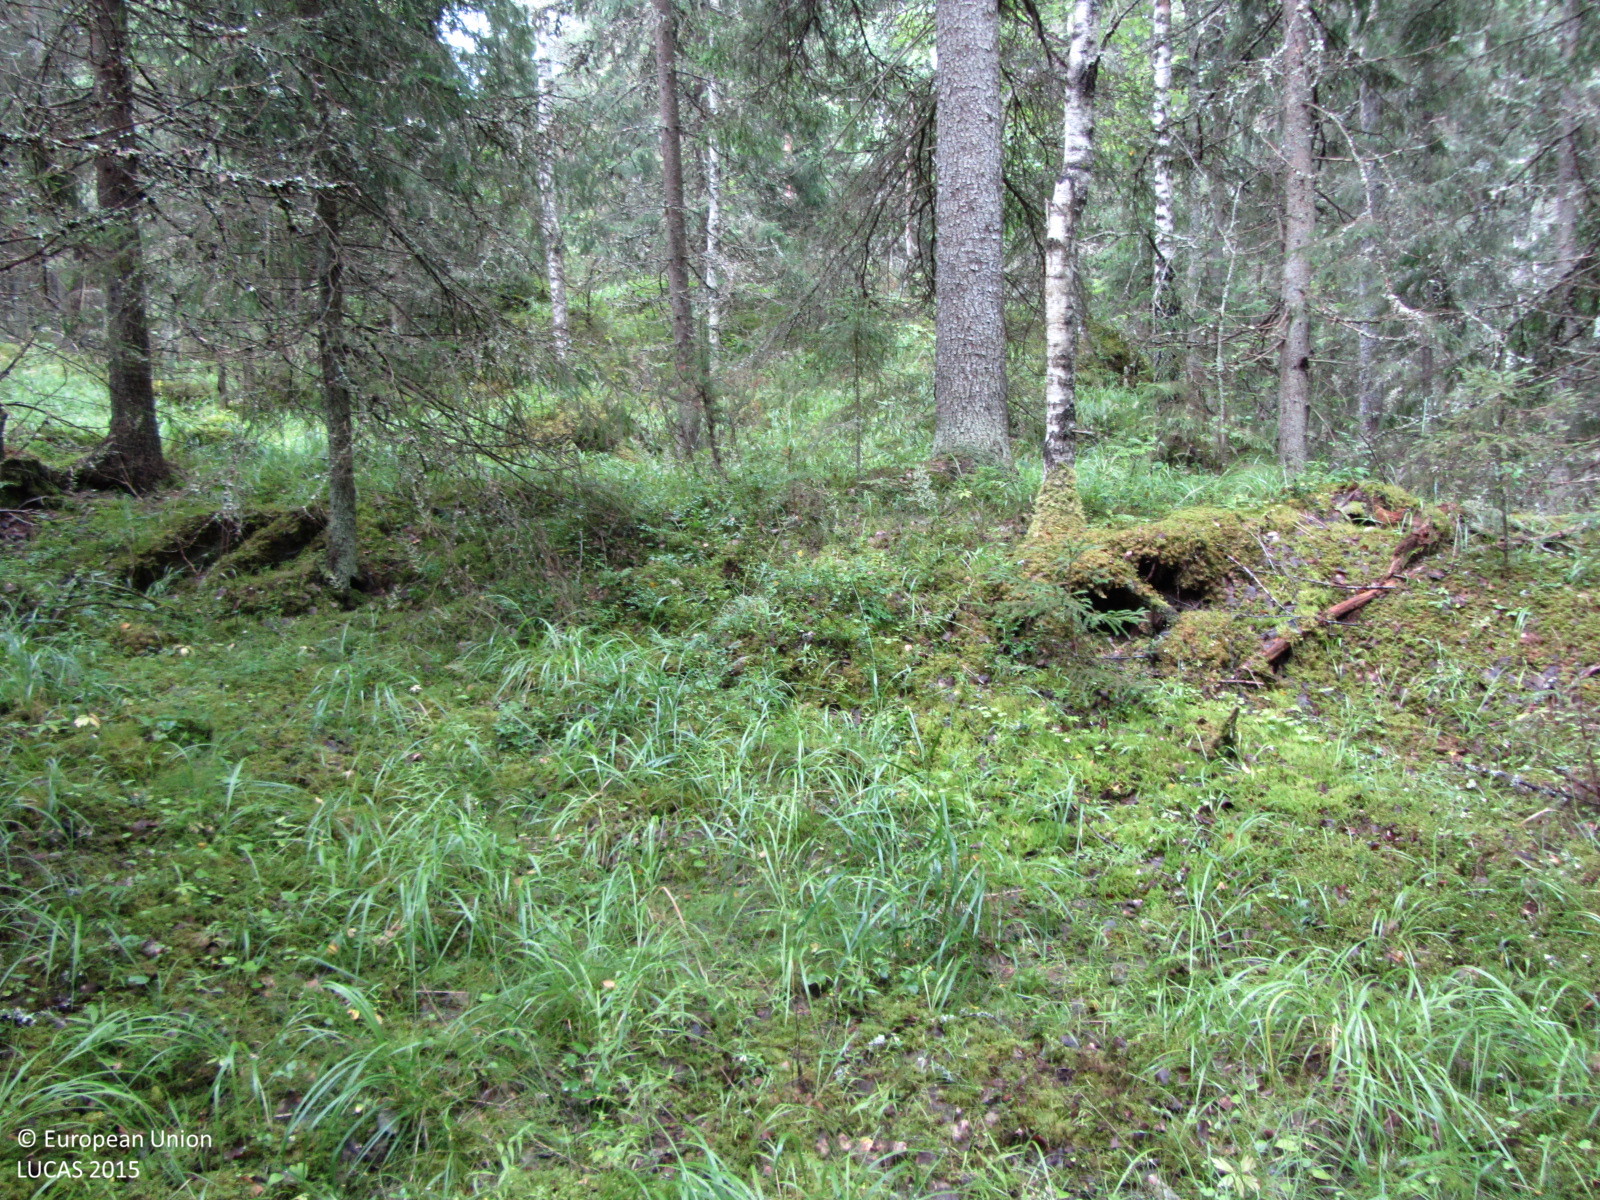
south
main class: Woodland
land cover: Spruce dominated mixed woodland
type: boreal forest
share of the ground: > 75 %
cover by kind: coniferous forest trees 60 %, broadleaved forest trees 20 %, lichens and mosses 10 %, shrubs 5 %, herbaceous plants 5 %
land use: Forestry
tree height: > 5 m
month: July
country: FI
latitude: 60.4870
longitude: 24.3525
